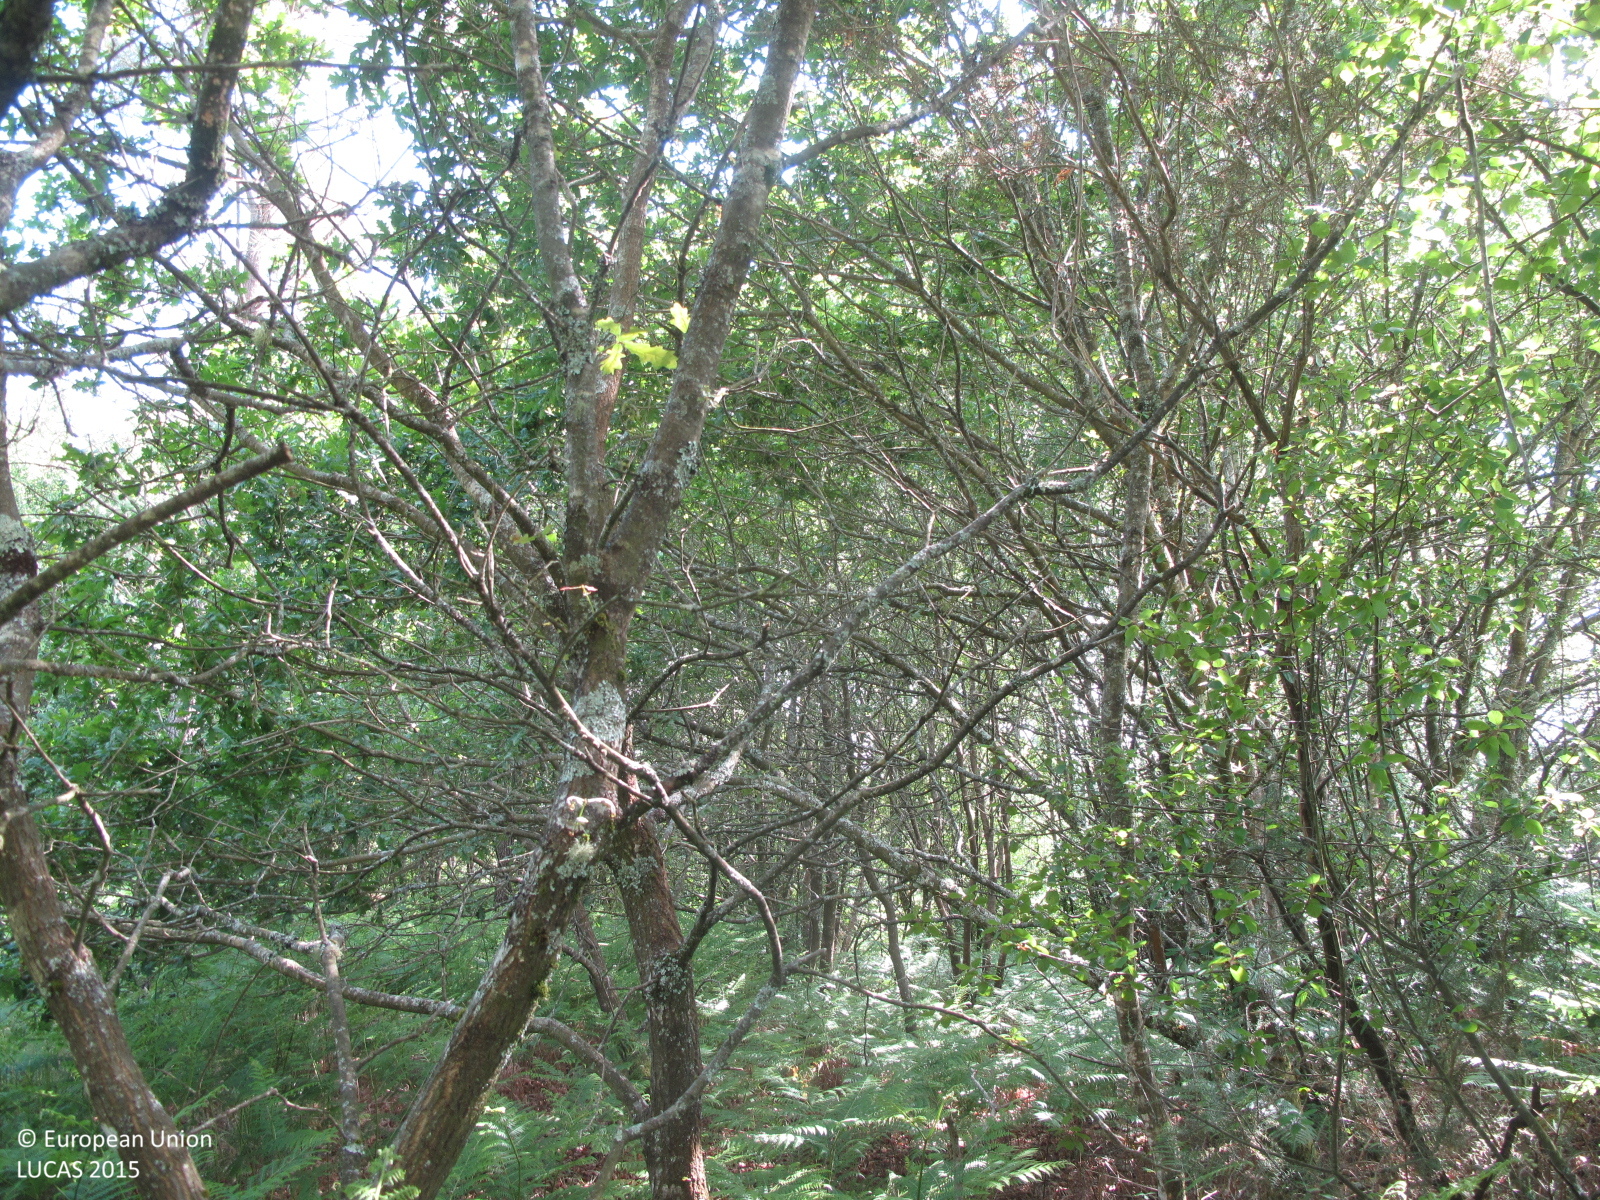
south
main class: Woodland
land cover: Broadleaved woodland
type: acidophilous oak and oak-birch forest
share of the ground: 25 - 50 %
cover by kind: herbaceous plants 60 %, broadleaved forest trees 30 %, shrubs 10 %
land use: Forestry
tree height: > 5 m
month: June
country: ES
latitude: 42.9504
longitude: -8.4767
